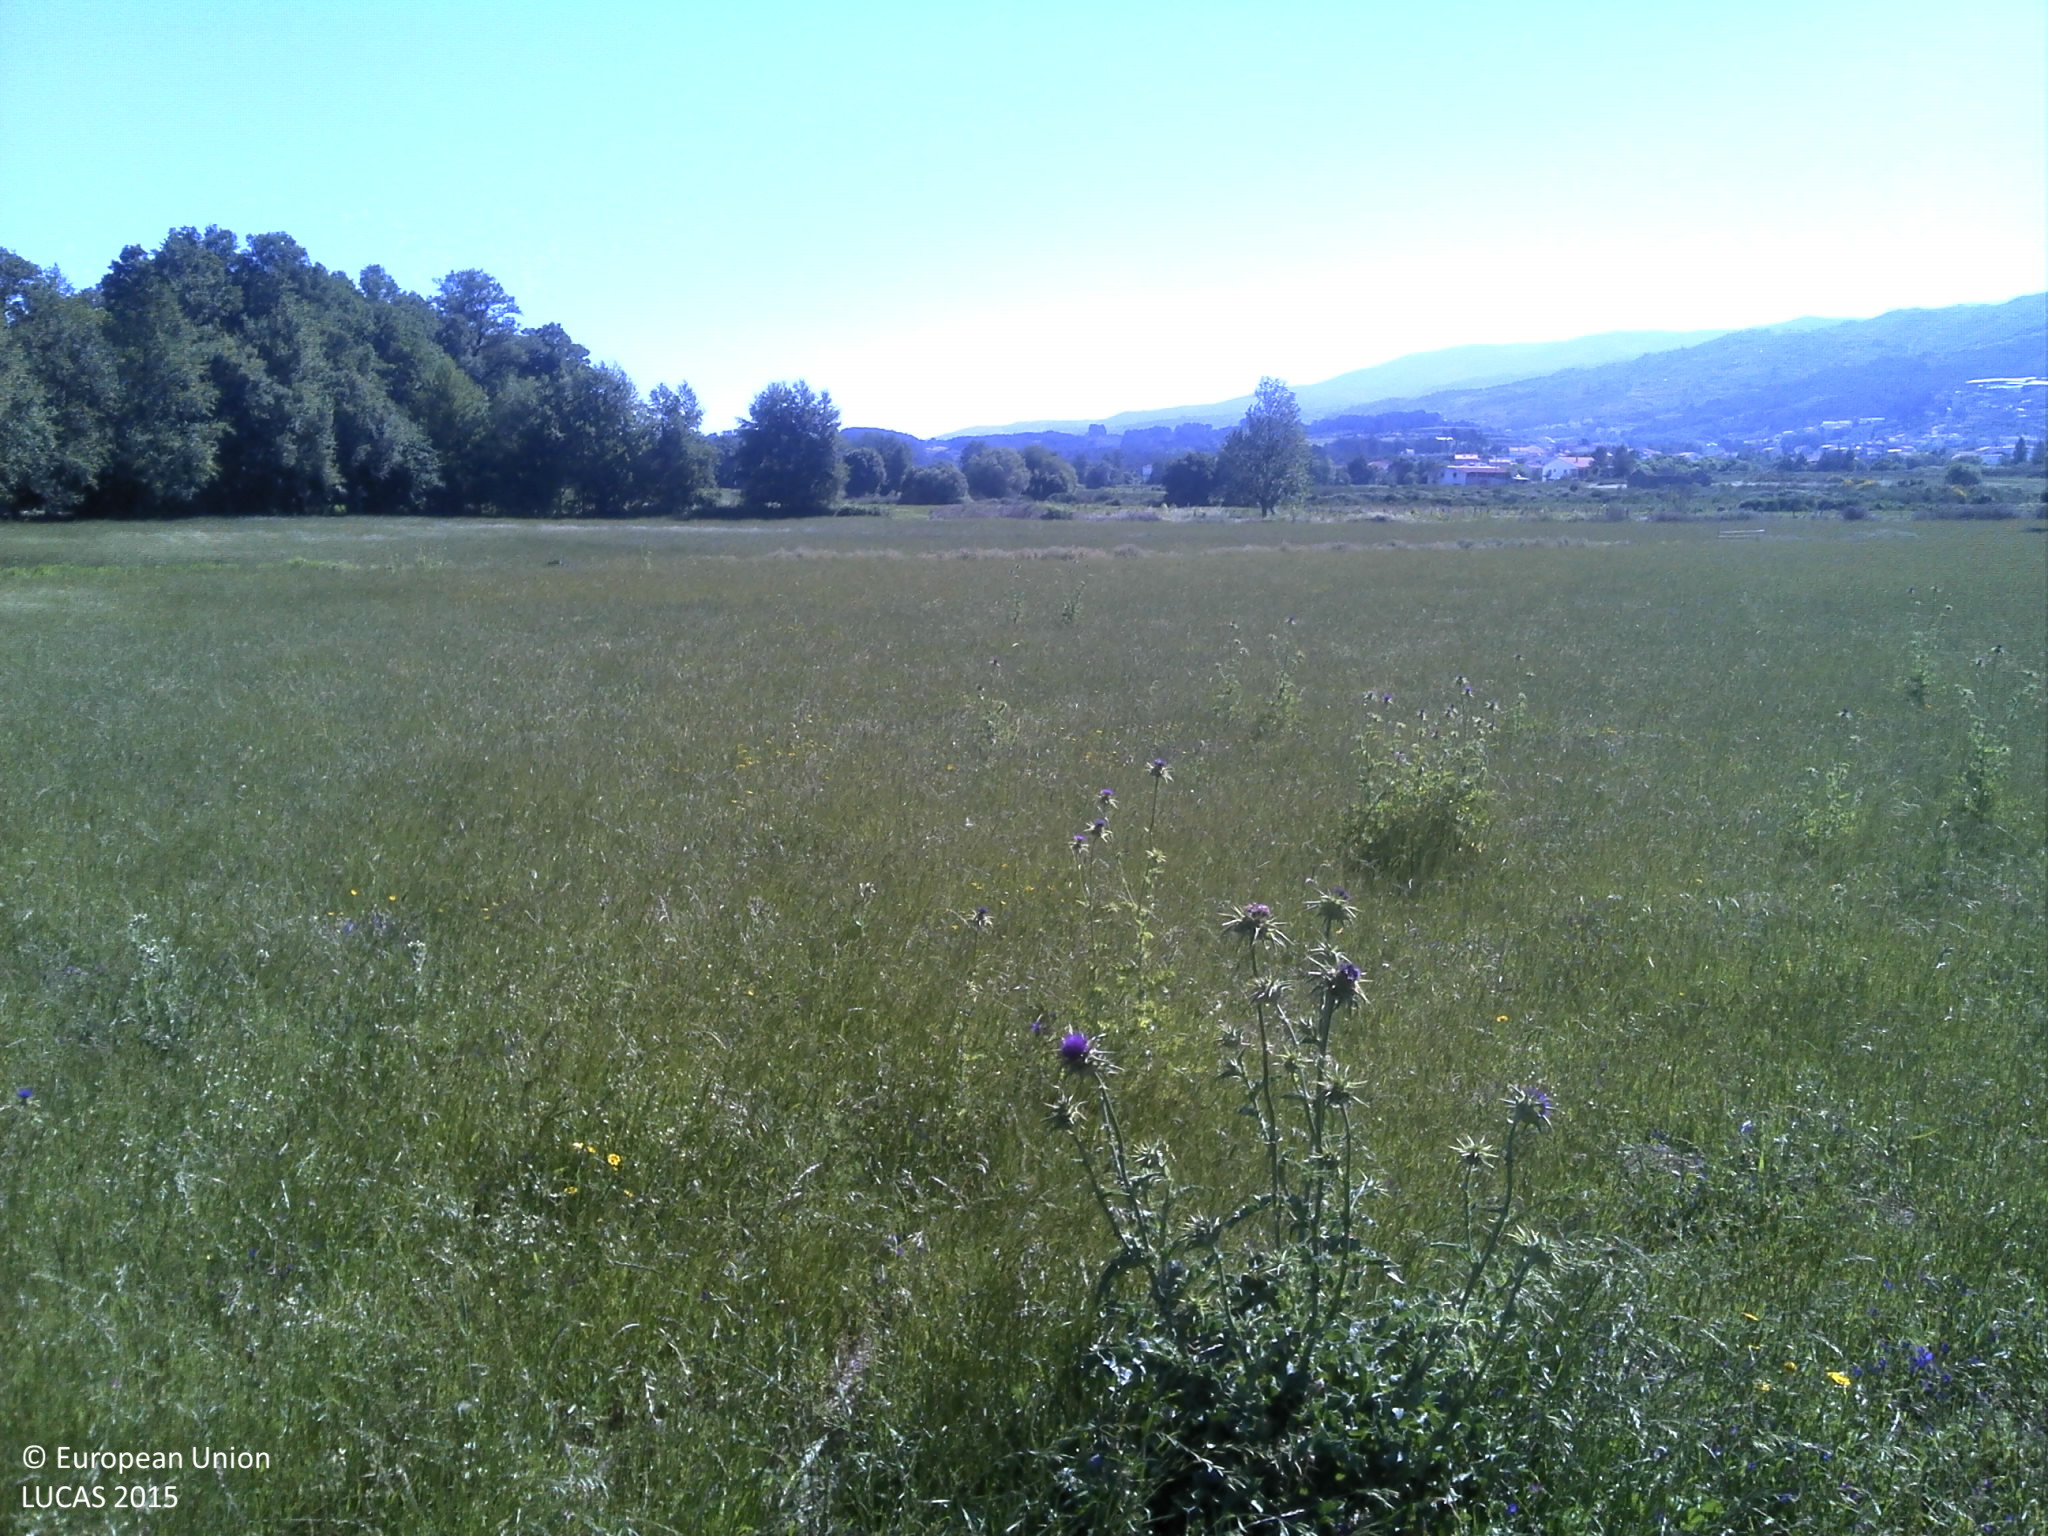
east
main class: Grassland
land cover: Grassland without tree/shrub cover
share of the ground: > 75 %
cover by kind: herbaceous plants 90 %, unconsolidated bare surface 10 %
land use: Agriculture (excluding fallow land and kitchen gardens)
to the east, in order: Grassland without tree/shrub cover; Single bushes/trees; Ditches and canals; Grassland without tree/shrub cover; Fences; Ditches and canals; Other bare soil; Fences; Grassland without tree/shrub cover
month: May
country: PT
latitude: 40.4319
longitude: -7.7146
